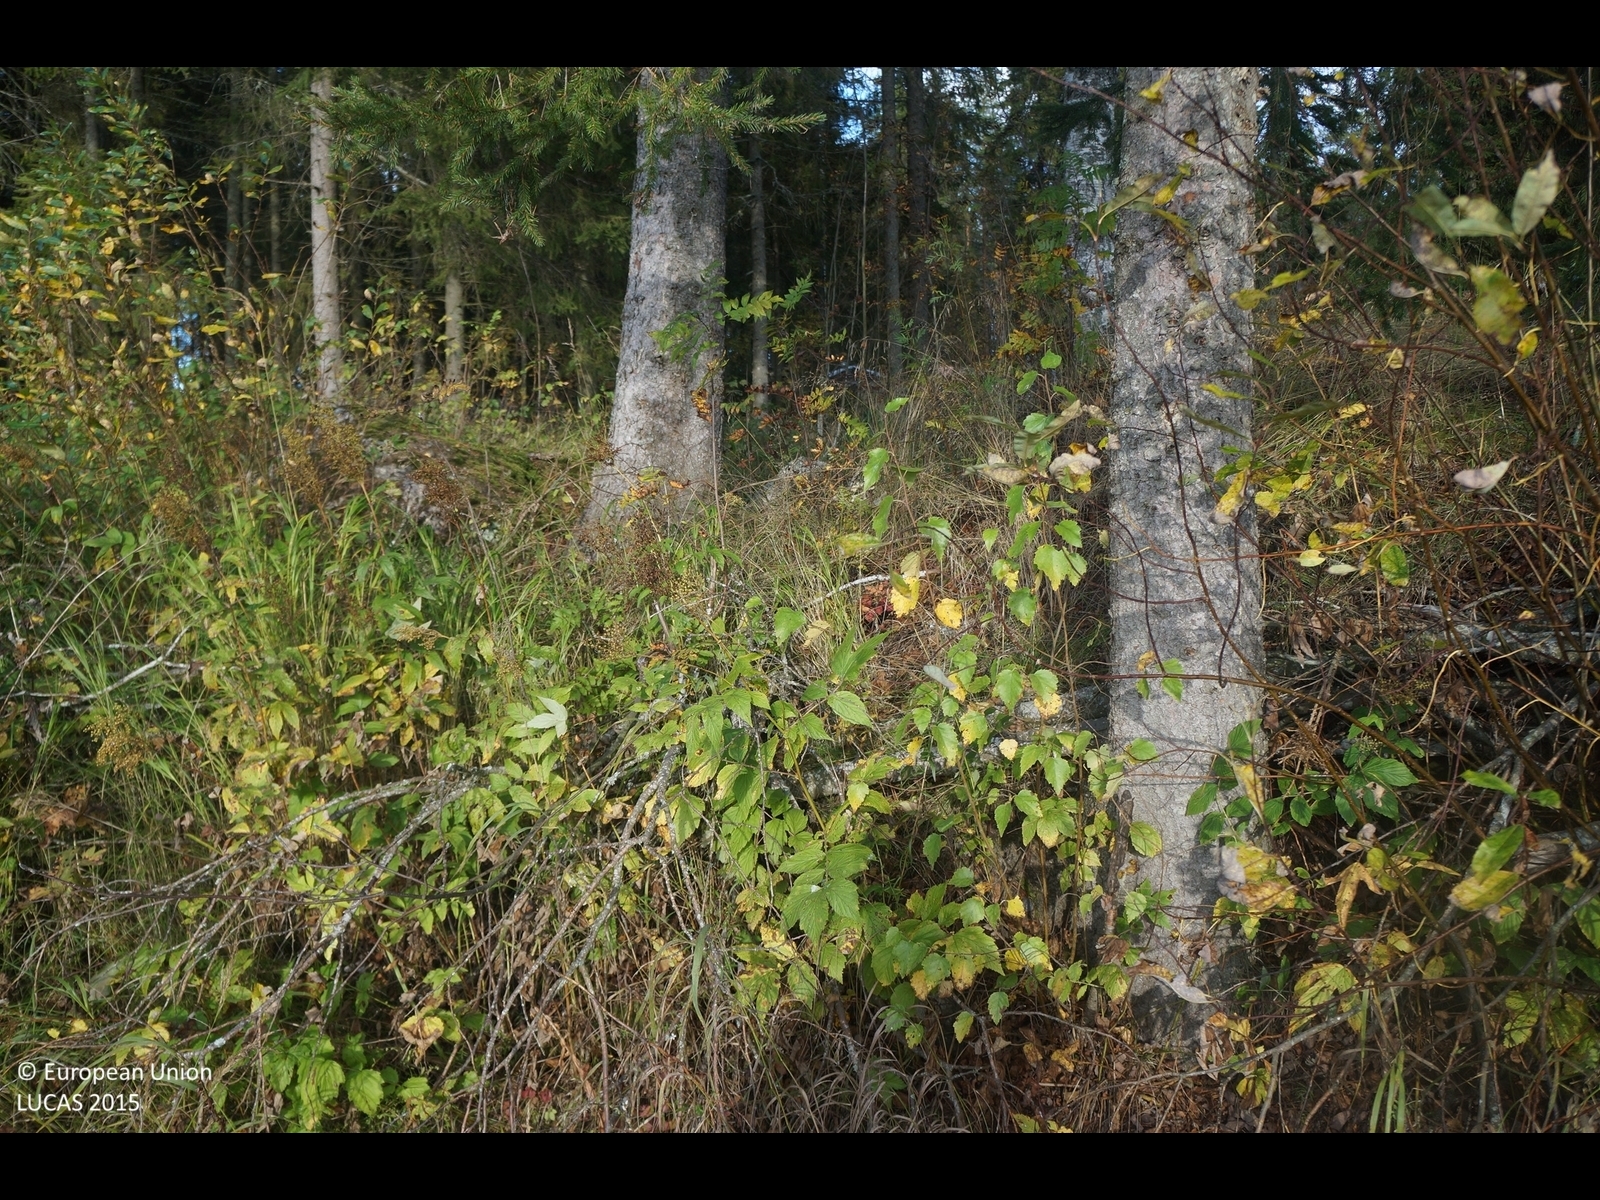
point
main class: Woodland
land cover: Spruce dominated mixed woodland
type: boreal forest
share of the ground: 50 - 75 %
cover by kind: coniferous forest trees 50 %, broadleaved forest trees 20 %, shrubs 20 %, lichens and mosses 10 %
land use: Forestry
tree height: > 5 m
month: September
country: FI
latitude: 64.2721
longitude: 24.5881
